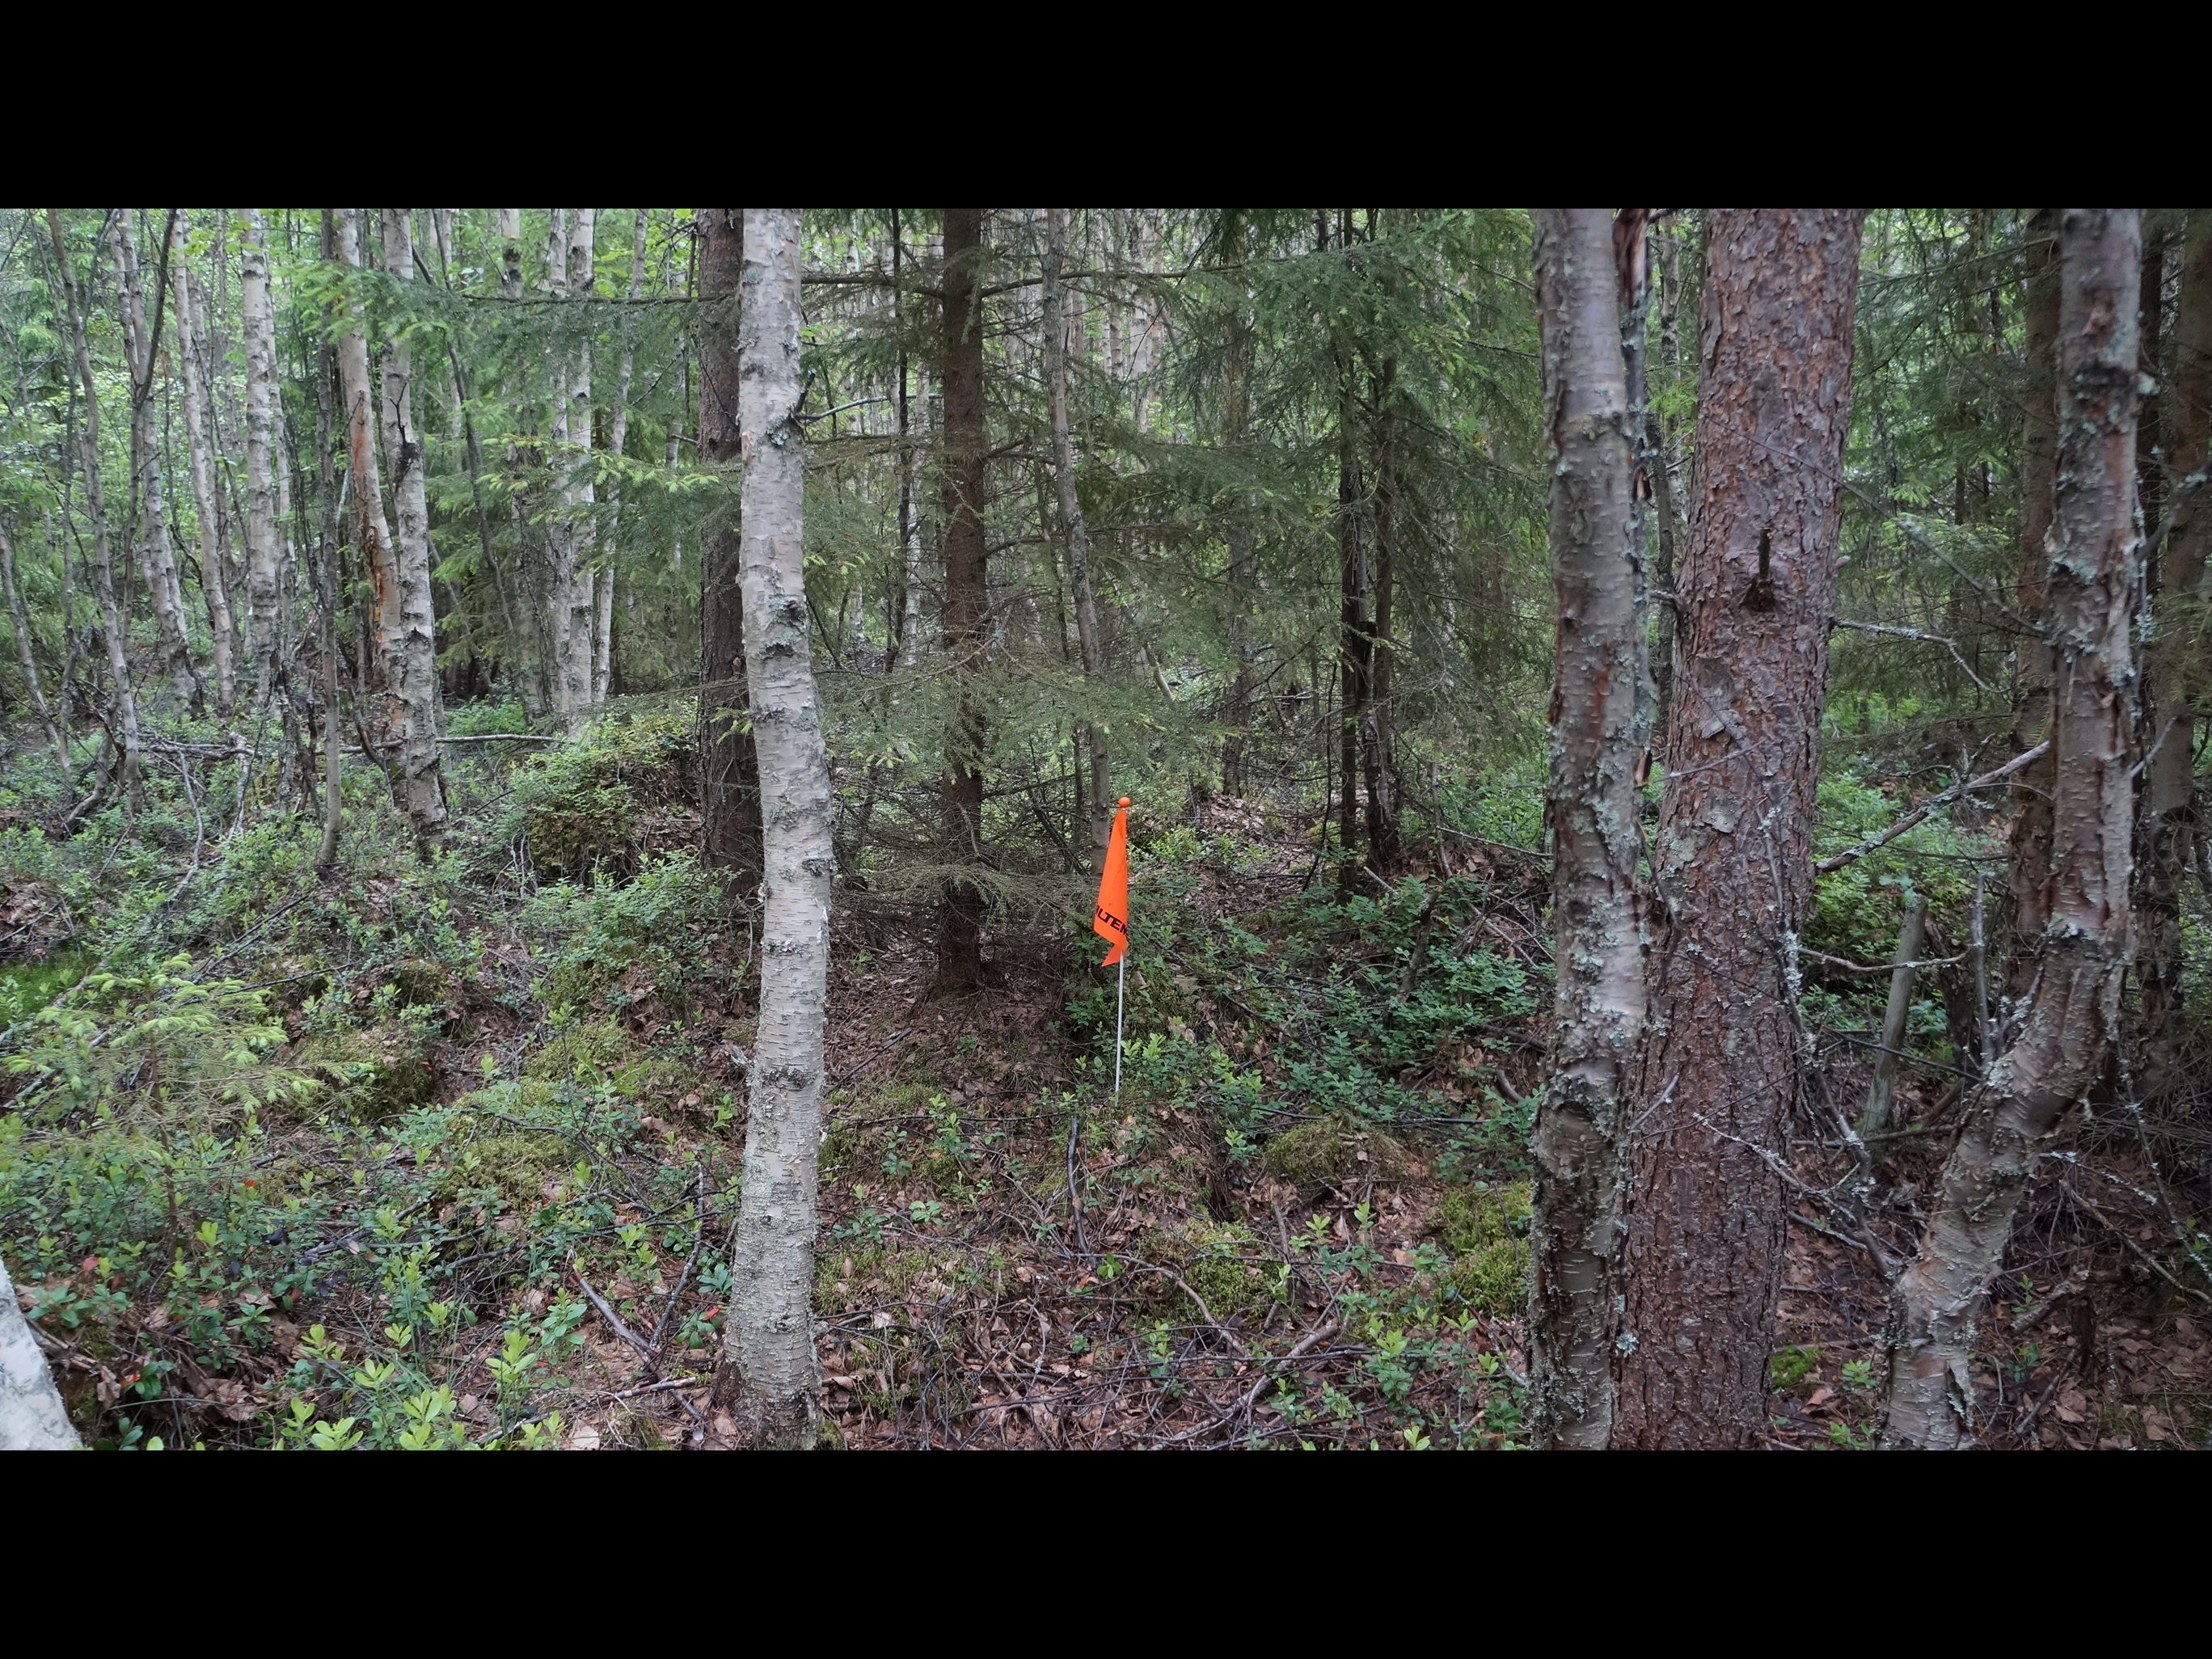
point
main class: Woodland
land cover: Other mixed woodland
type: boreal forest
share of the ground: > 75 %
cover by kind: coniferous forest trees 40 %, broadleaved forest trees 35 %, shrubs 20 %, lichens and mosses 5 %
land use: Forestry
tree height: > 5 m
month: June
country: FI
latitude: 63.8927
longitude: 23.2733
